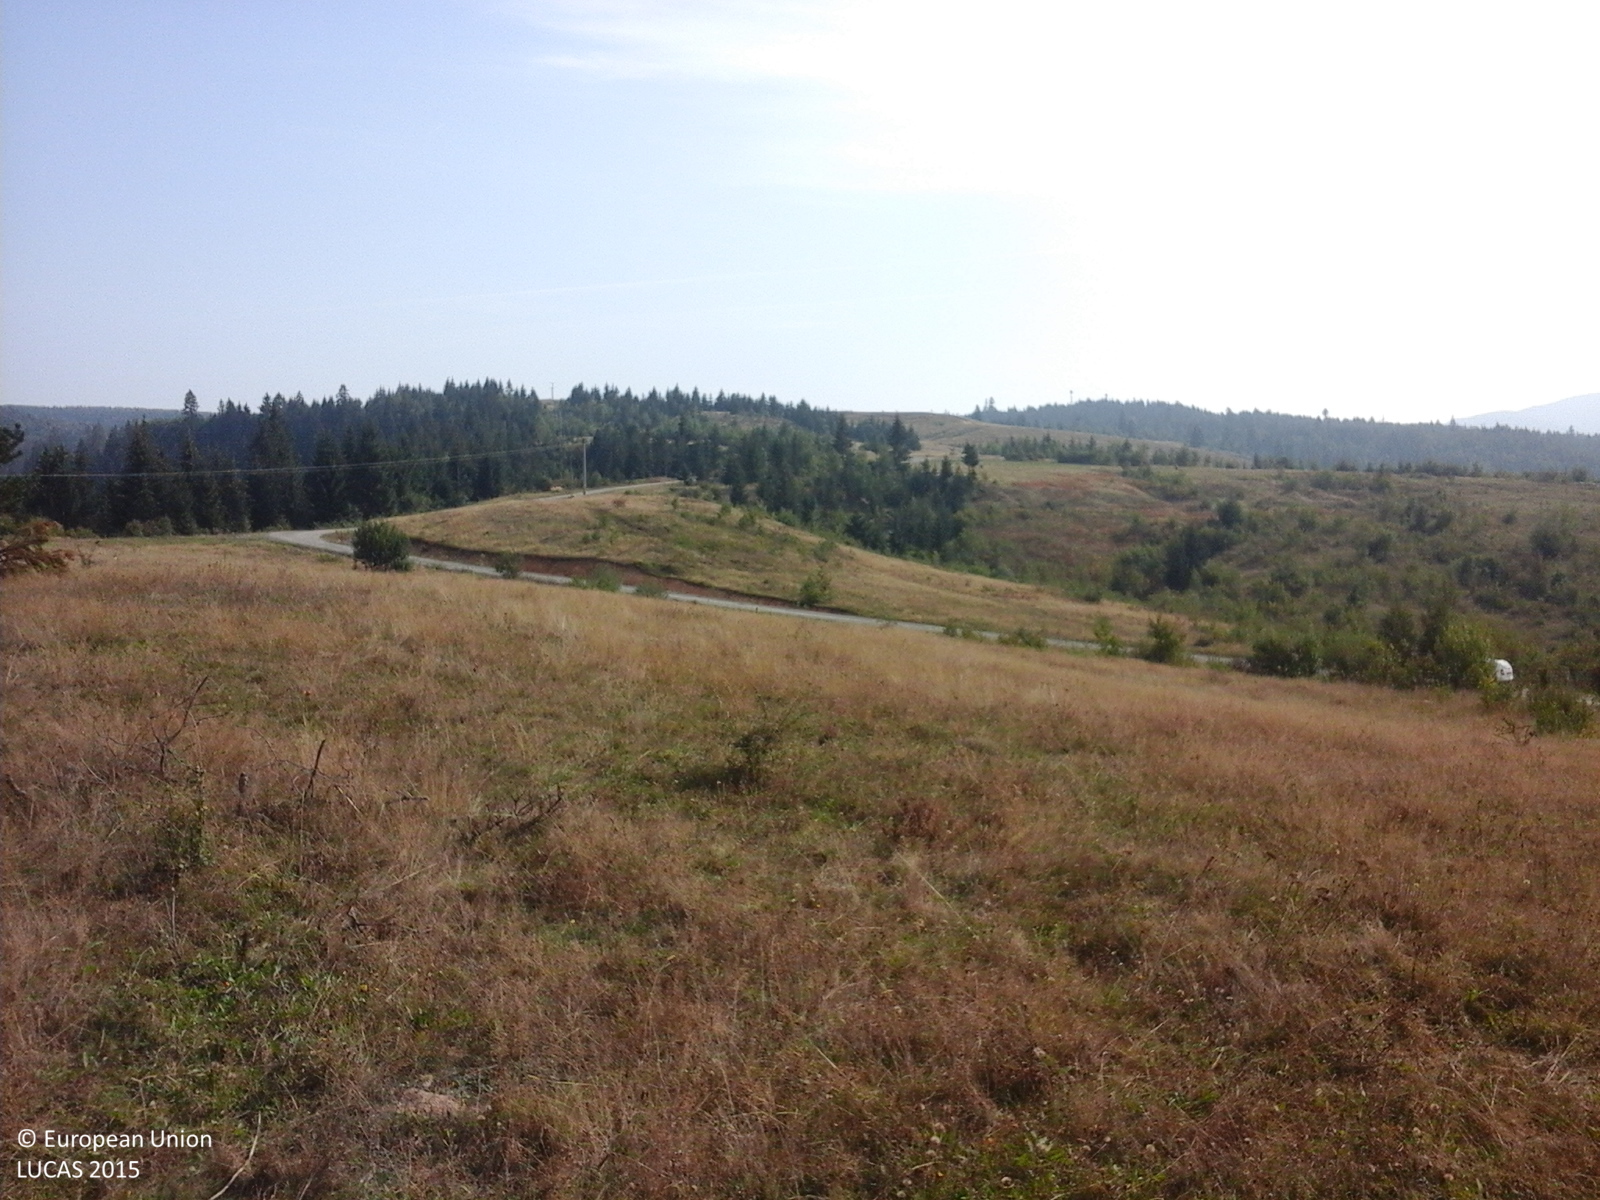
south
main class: Grassland
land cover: Grassland without tree/shrub cover
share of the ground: > 75 %
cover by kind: herbaceous plants 100 %
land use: Agriculture (excluding fallow land and kitchen gardens)
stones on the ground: < 10 %
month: September
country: RO
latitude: 46.7561
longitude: 23.0087
